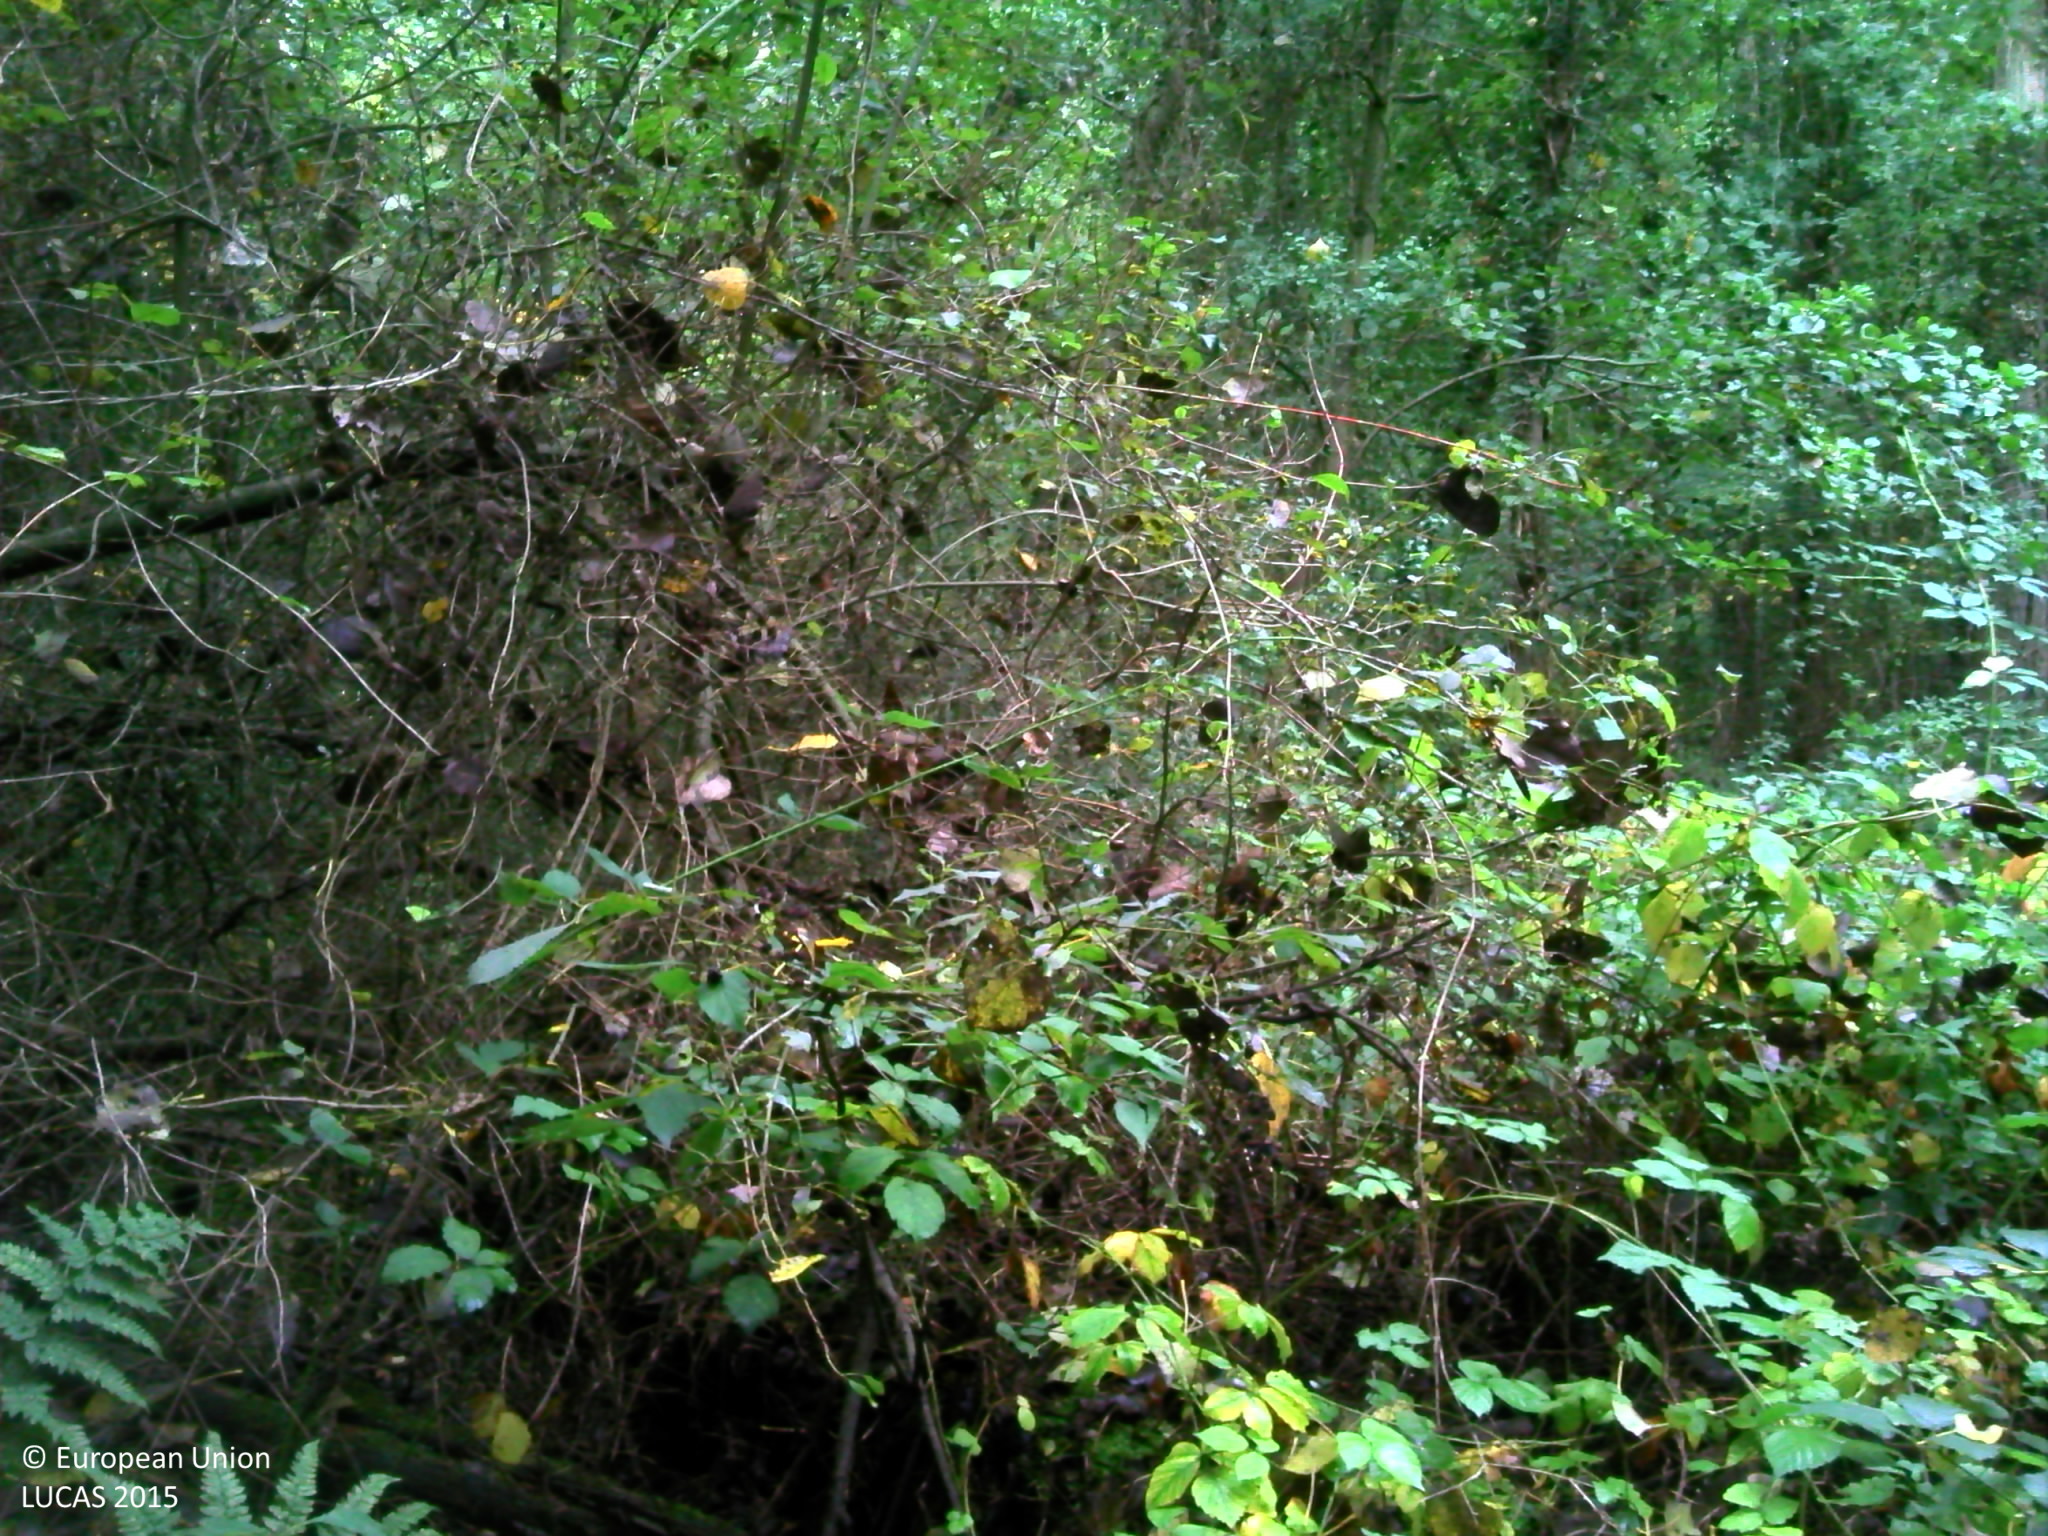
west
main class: Woodland
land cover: Broadleaved woodland
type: non-riverine alder, birch or aspen forest
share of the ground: > 75 %
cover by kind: broadleaved forest trees 80 %, herbaceous plants 20 %
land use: Forestry
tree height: > 5 m
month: October
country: BE
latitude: 51.0216
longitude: 4.8216
